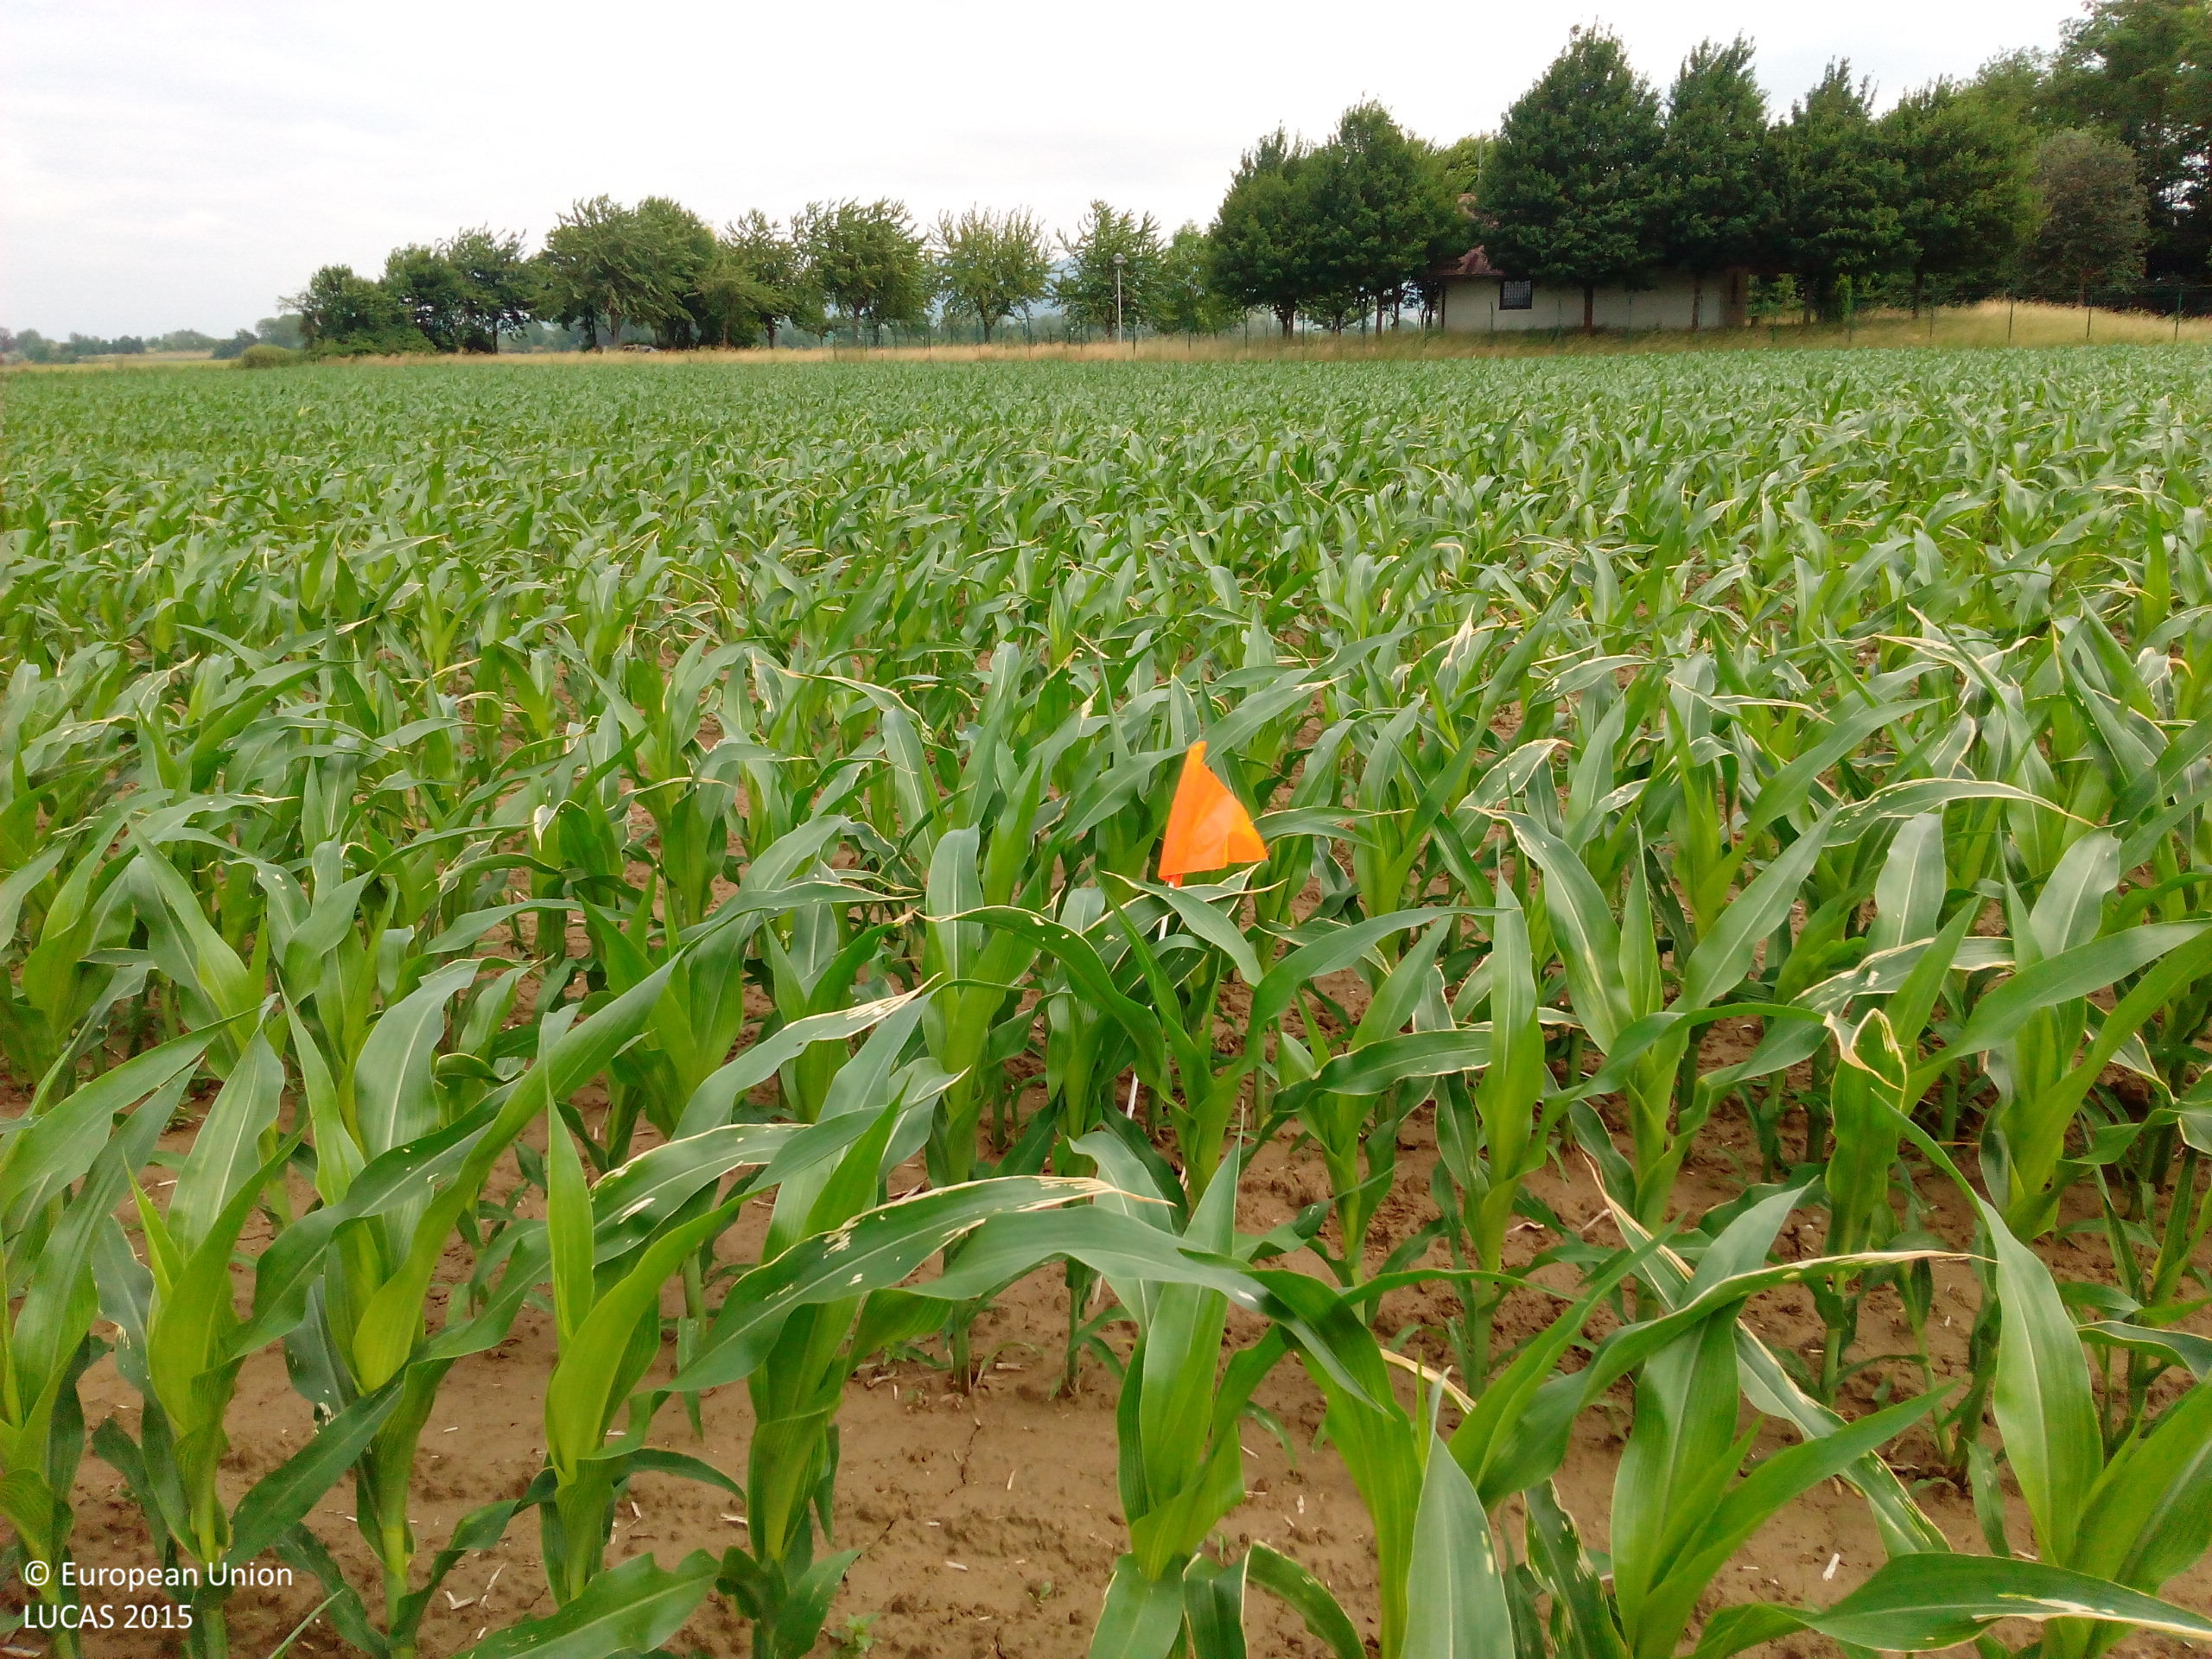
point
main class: Cropland
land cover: Maize
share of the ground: > 75 %
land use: Agriculture (excluding fallow land and kitchen gardens)
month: June
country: DE
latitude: 48.1619
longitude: 7.6214
